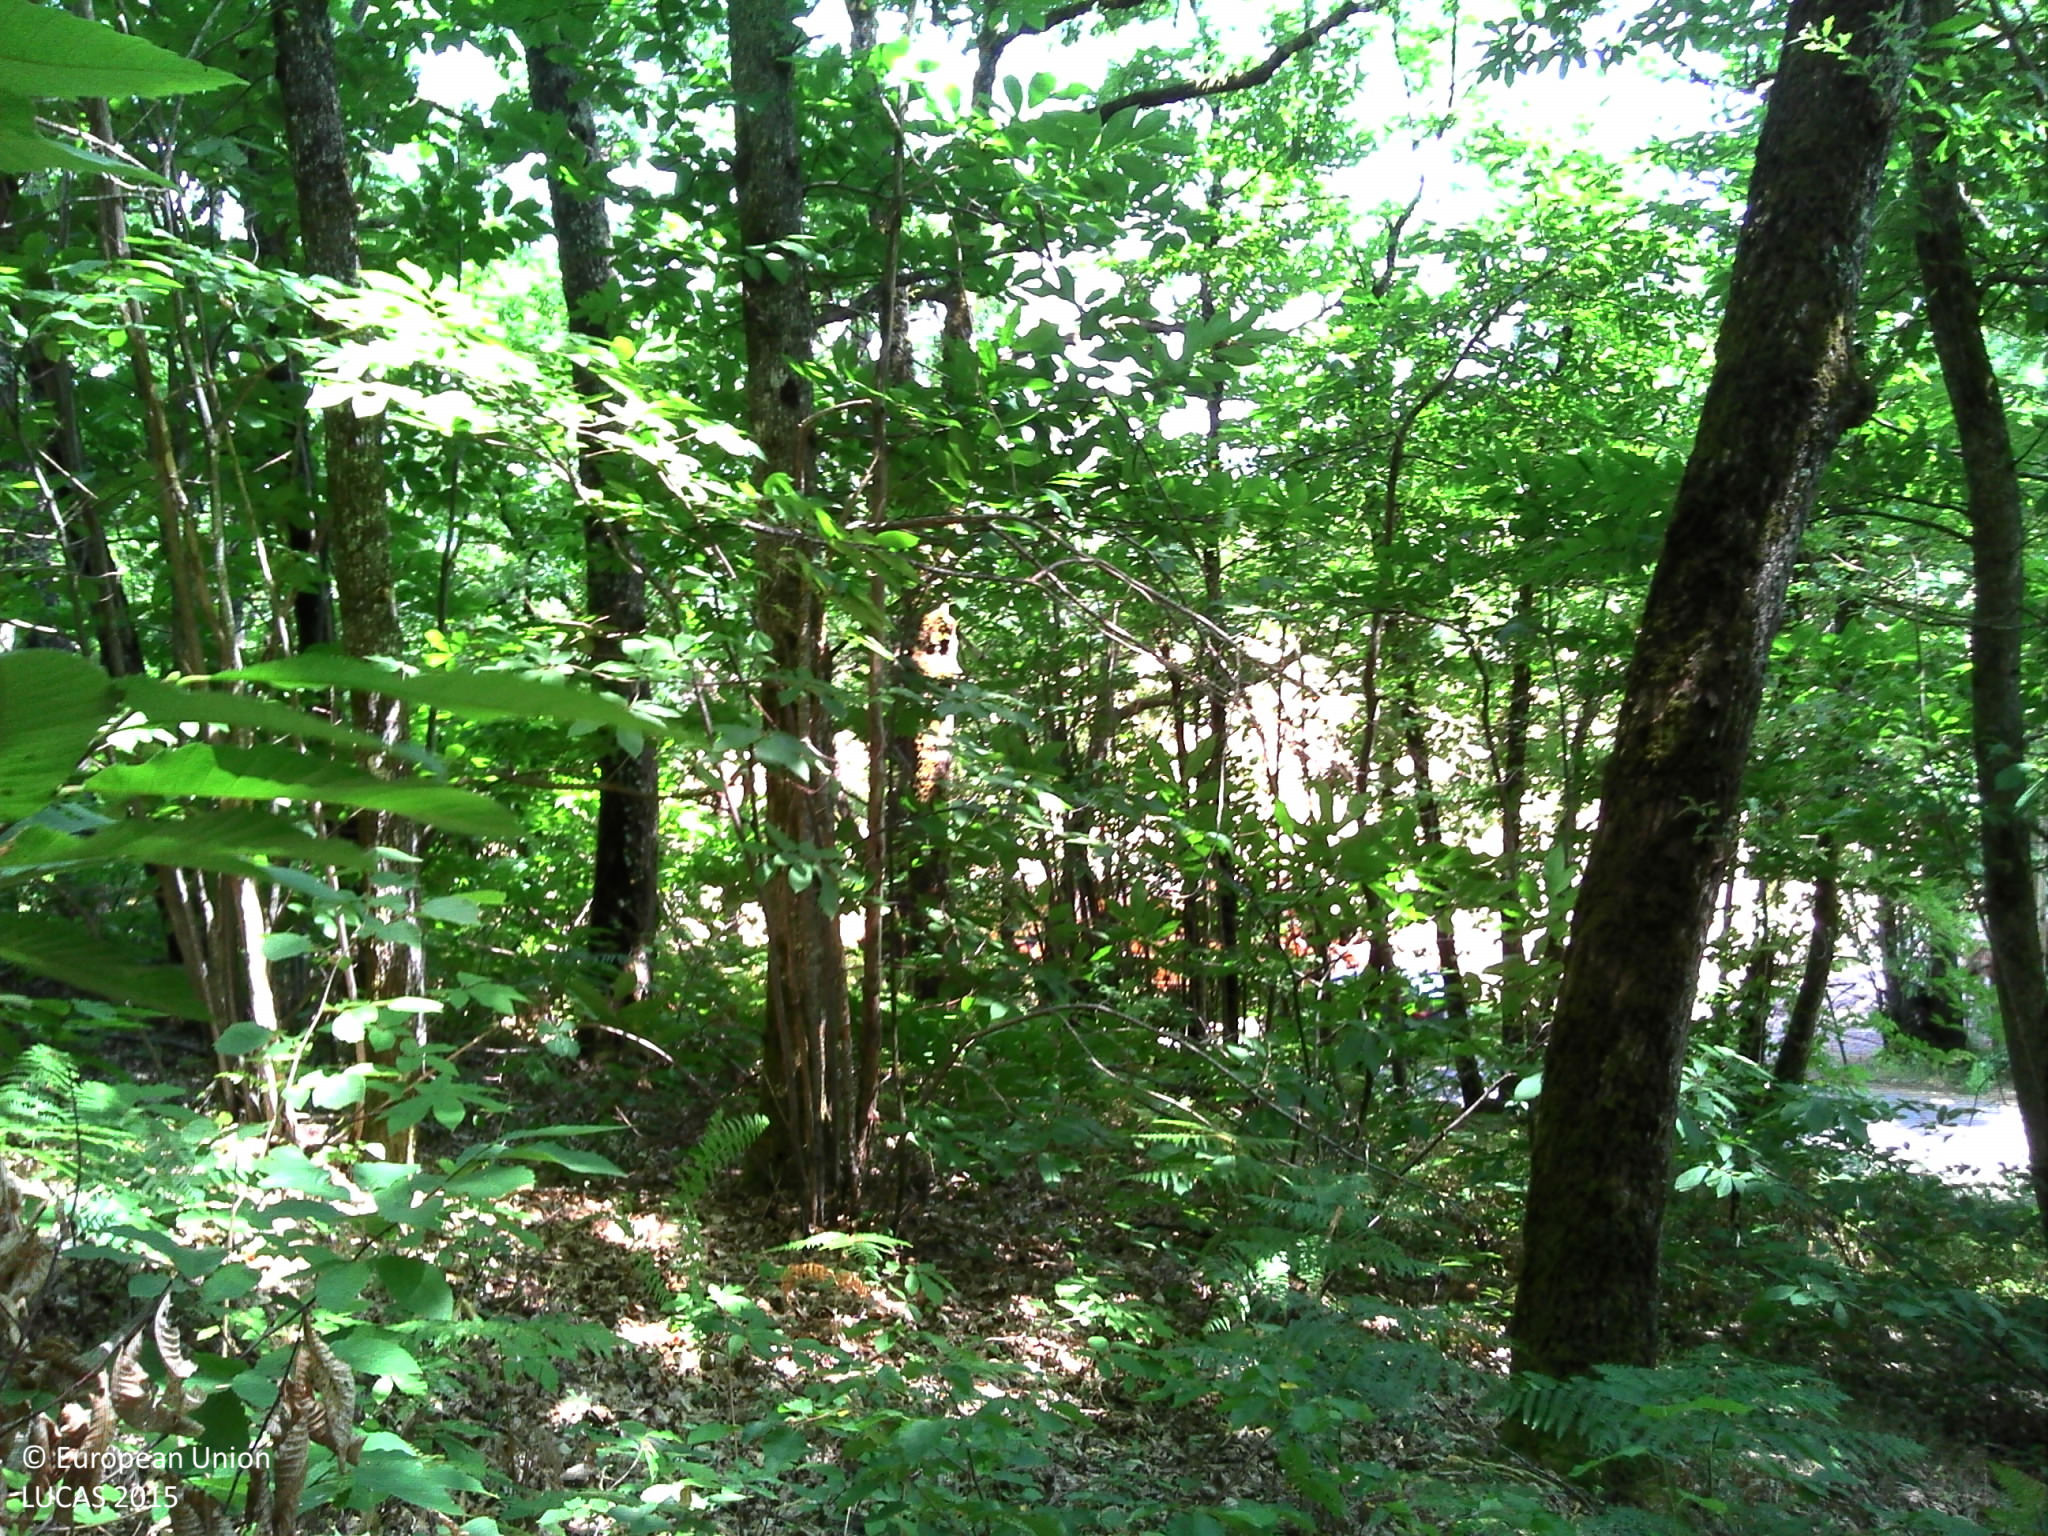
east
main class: Woodland
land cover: Broadleaved woodland
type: acidophilous oak and oak-birch forest
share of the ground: > 75 %
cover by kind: broadleaved forest trees 75 %, herbaceous plants 20 %, lichens and mosses 5 %
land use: Forestry
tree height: > 5 m
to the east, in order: Broadleaved woodland; Paved roads, cycling and walking lanes; Electric lines; Grass margins; Fences; Grassland without tree/shrub cover; Broadleaved woodland
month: July
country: FR
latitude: 45.1380
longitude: 0.7969
